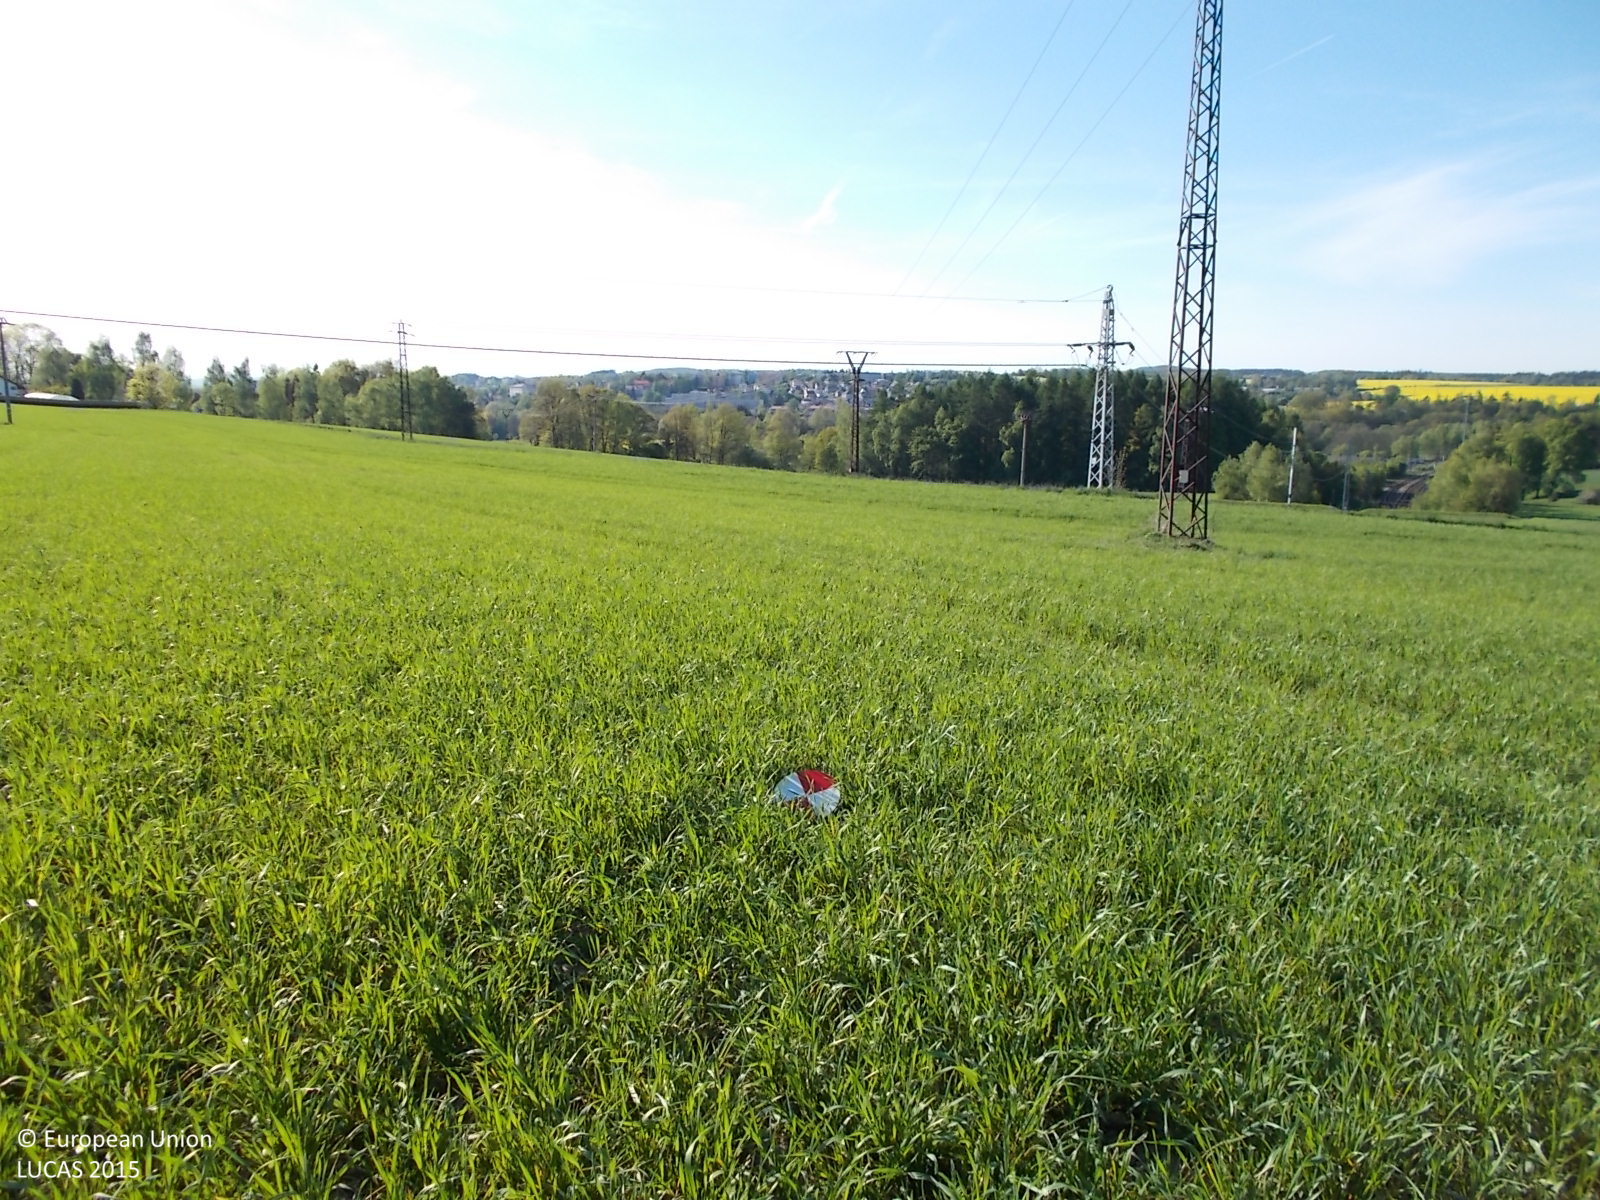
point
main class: Cropland
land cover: Common wheat
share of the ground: > 75 %
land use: Agriculture (excluding fallow land and kitchen gardens)
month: May
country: CZ
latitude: 49.5956
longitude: 15.6073
